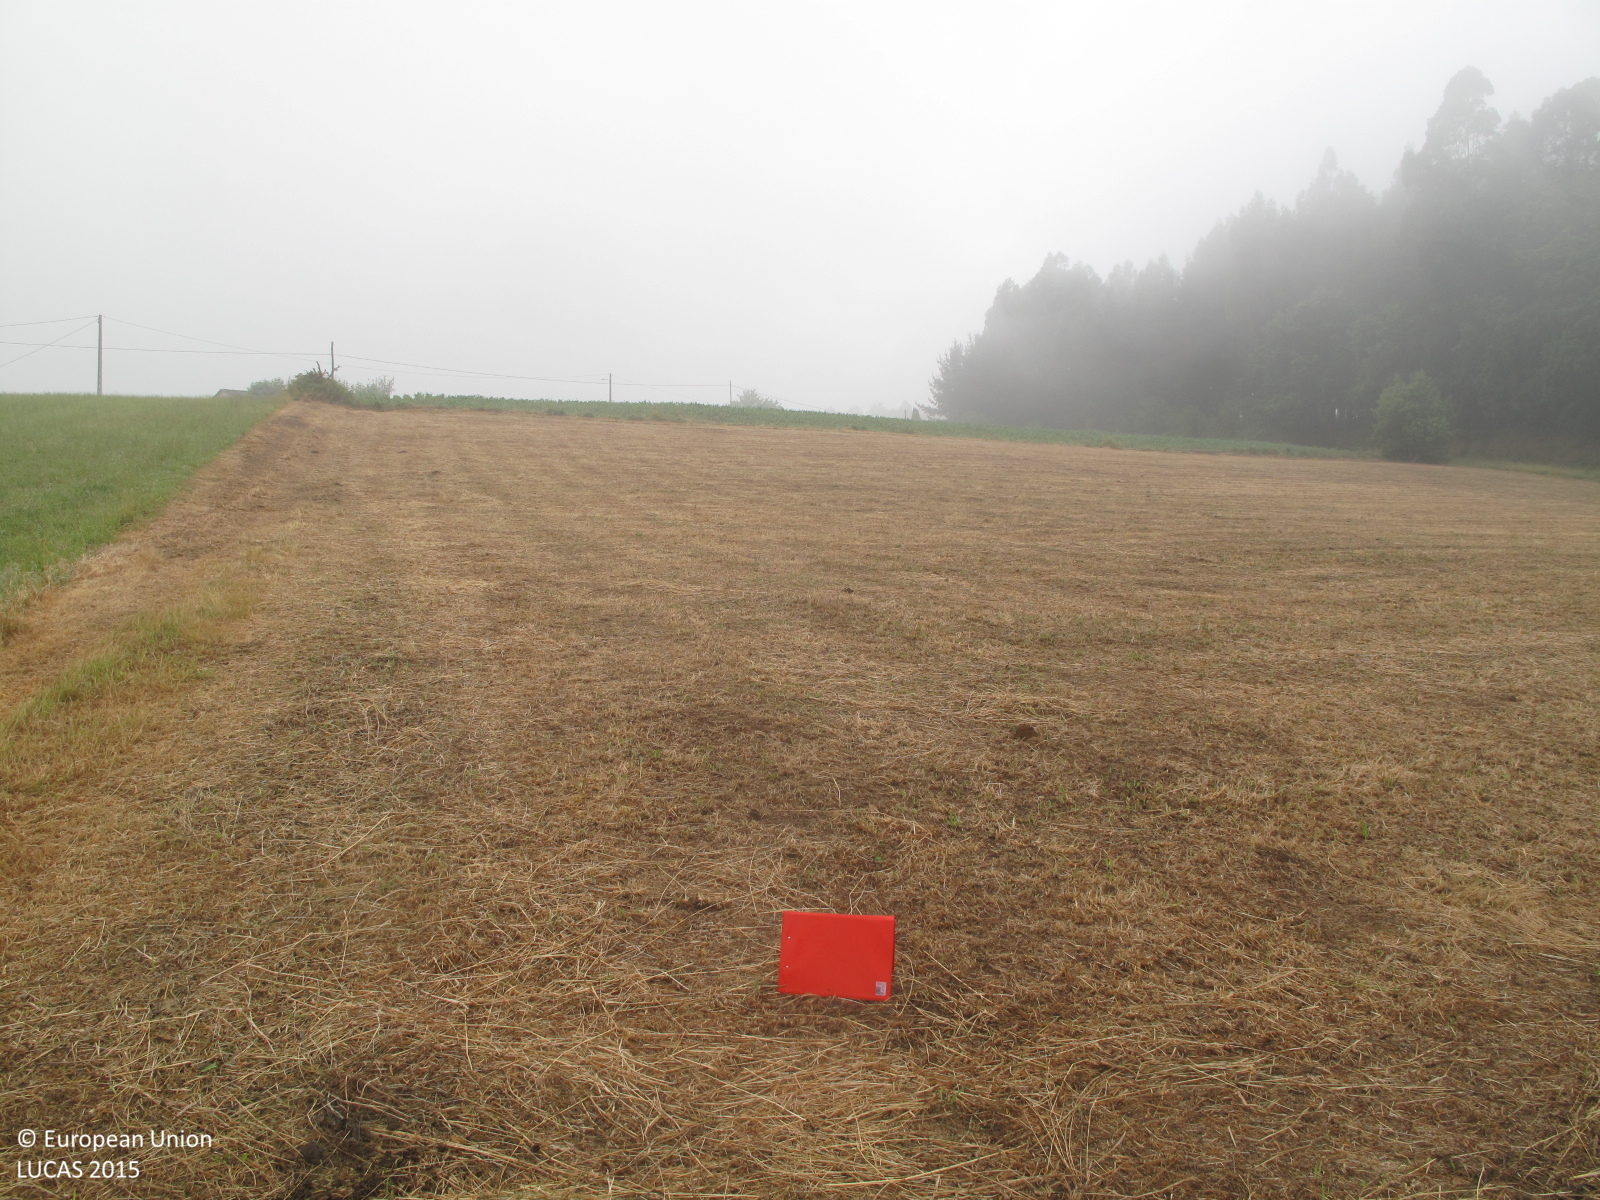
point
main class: Grassland
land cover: Grassland without tree/shrub cover
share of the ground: > 75 %
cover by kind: herbaceous plants 80 %, unconsolidated bare surface 20 %
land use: Agriculture (excluding fallow land and kitchen gardens)
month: June
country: ES
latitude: 43.1775
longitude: -8.2452
